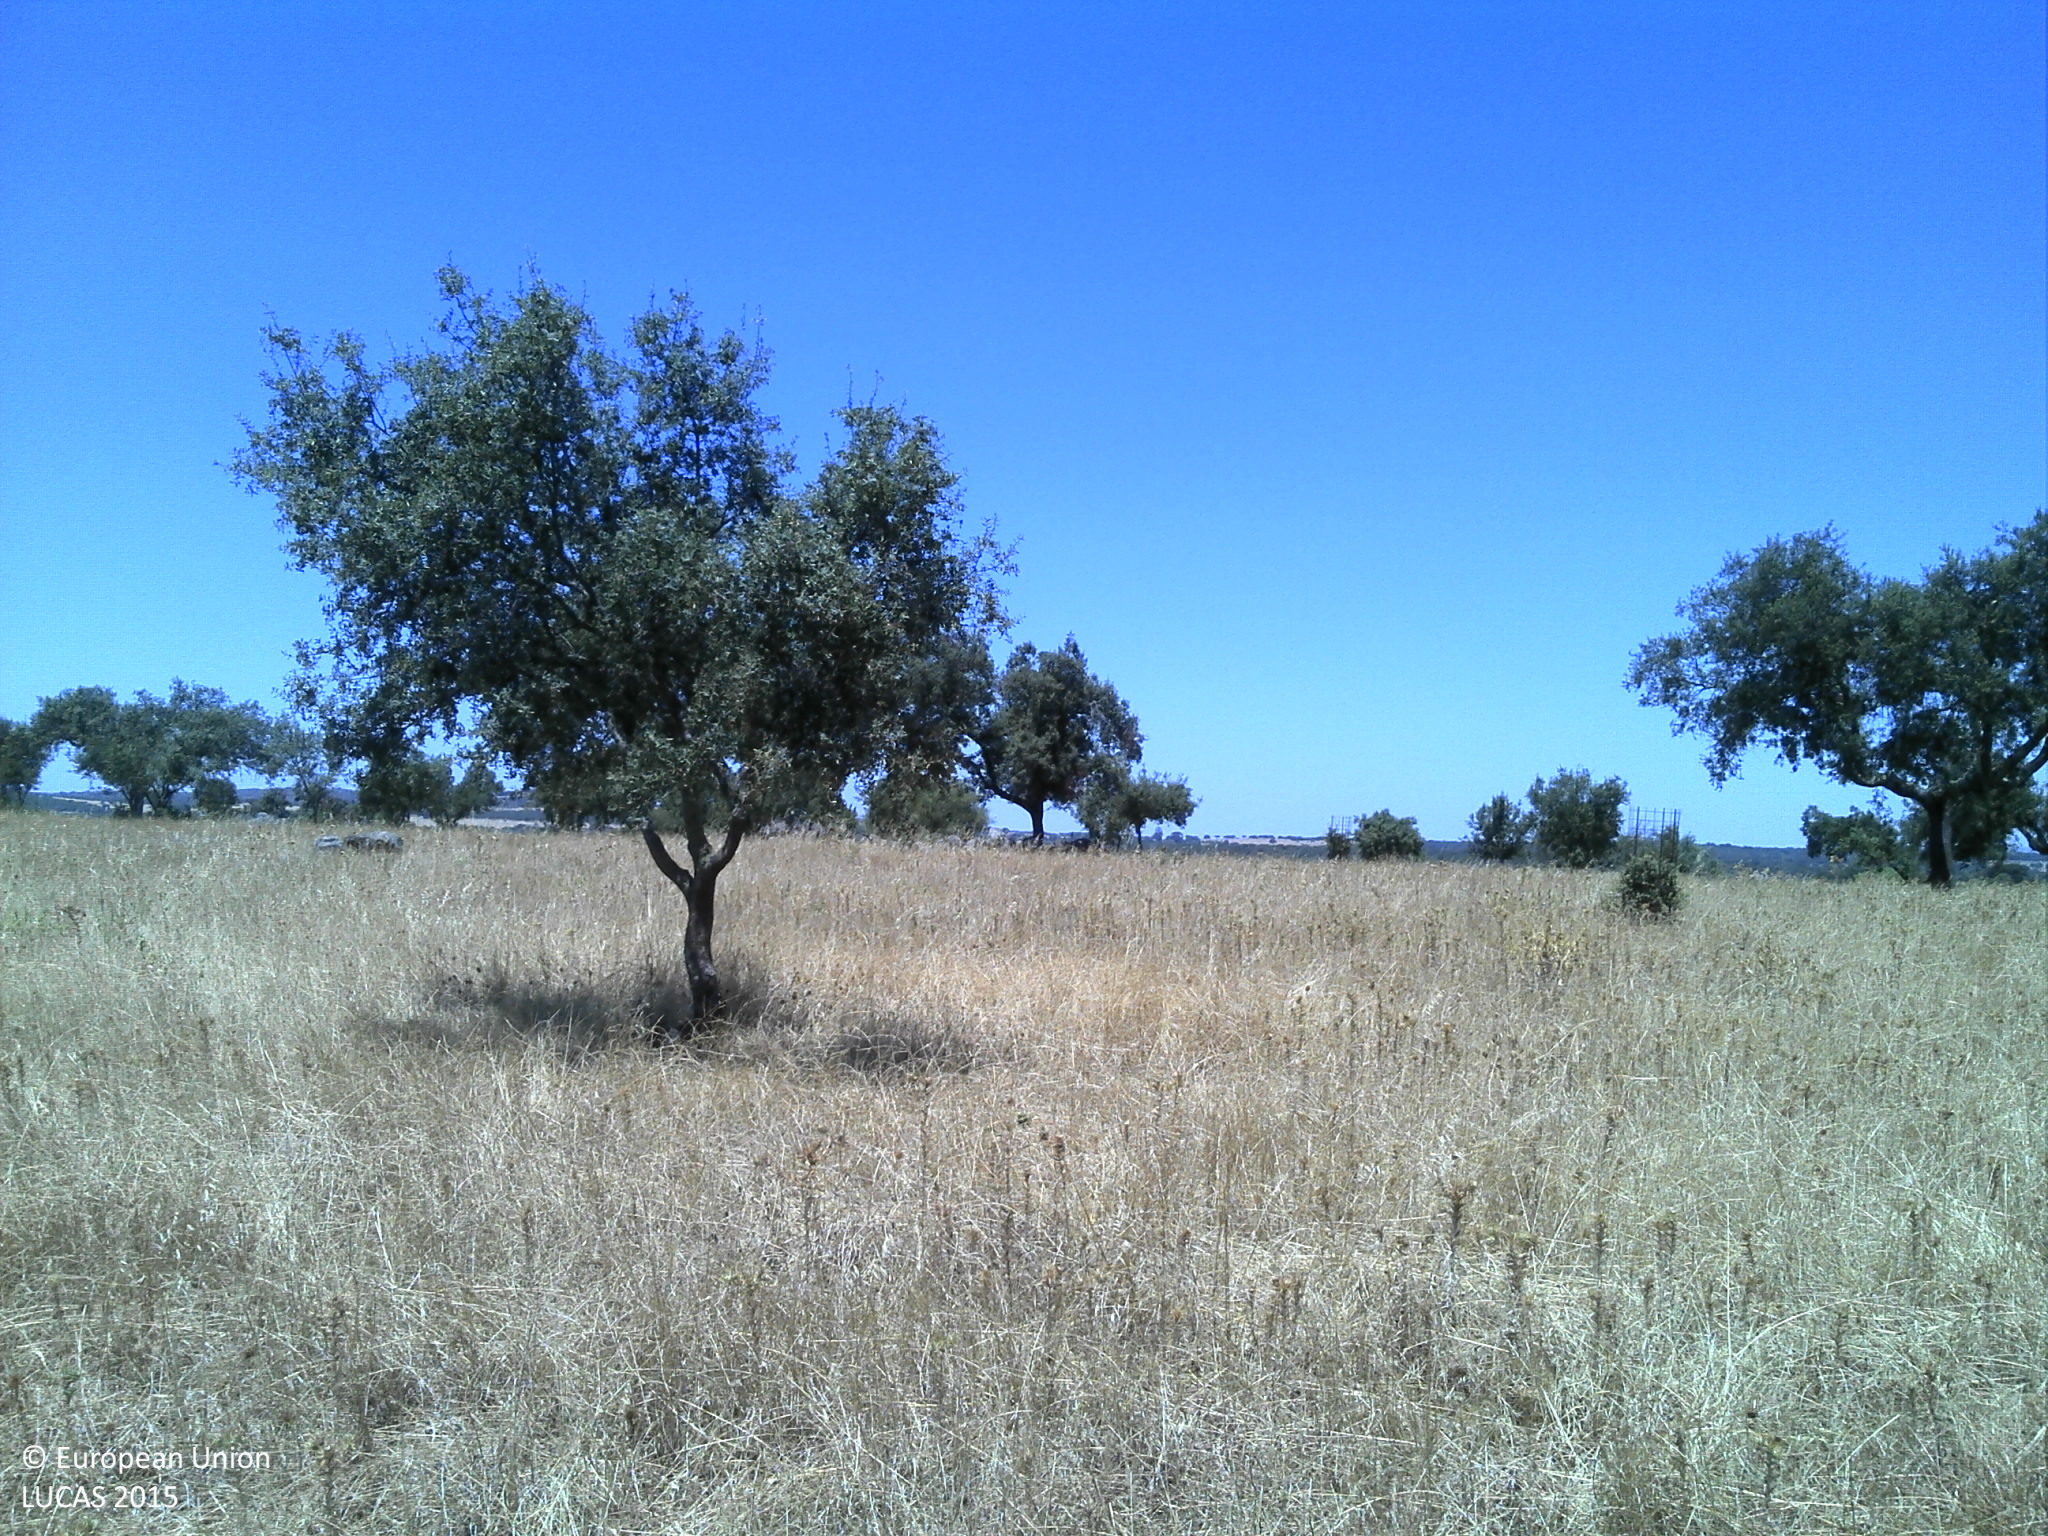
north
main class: Woodland
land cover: Broadleaved woodland
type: broadleaved evergreen forest
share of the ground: 10 - 25 %
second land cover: Grassland without tree/shrub cover
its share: 25 - 50 %
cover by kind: unconsolidated bare surface 55 %, herbaceous plants 25 %, broadleaved forest trees 20 %
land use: Forestry
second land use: Agriculture (excluding fallow land and kitchen gardens)
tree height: > 5 m
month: July
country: PT
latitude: 39.1299
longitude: -7.5670
